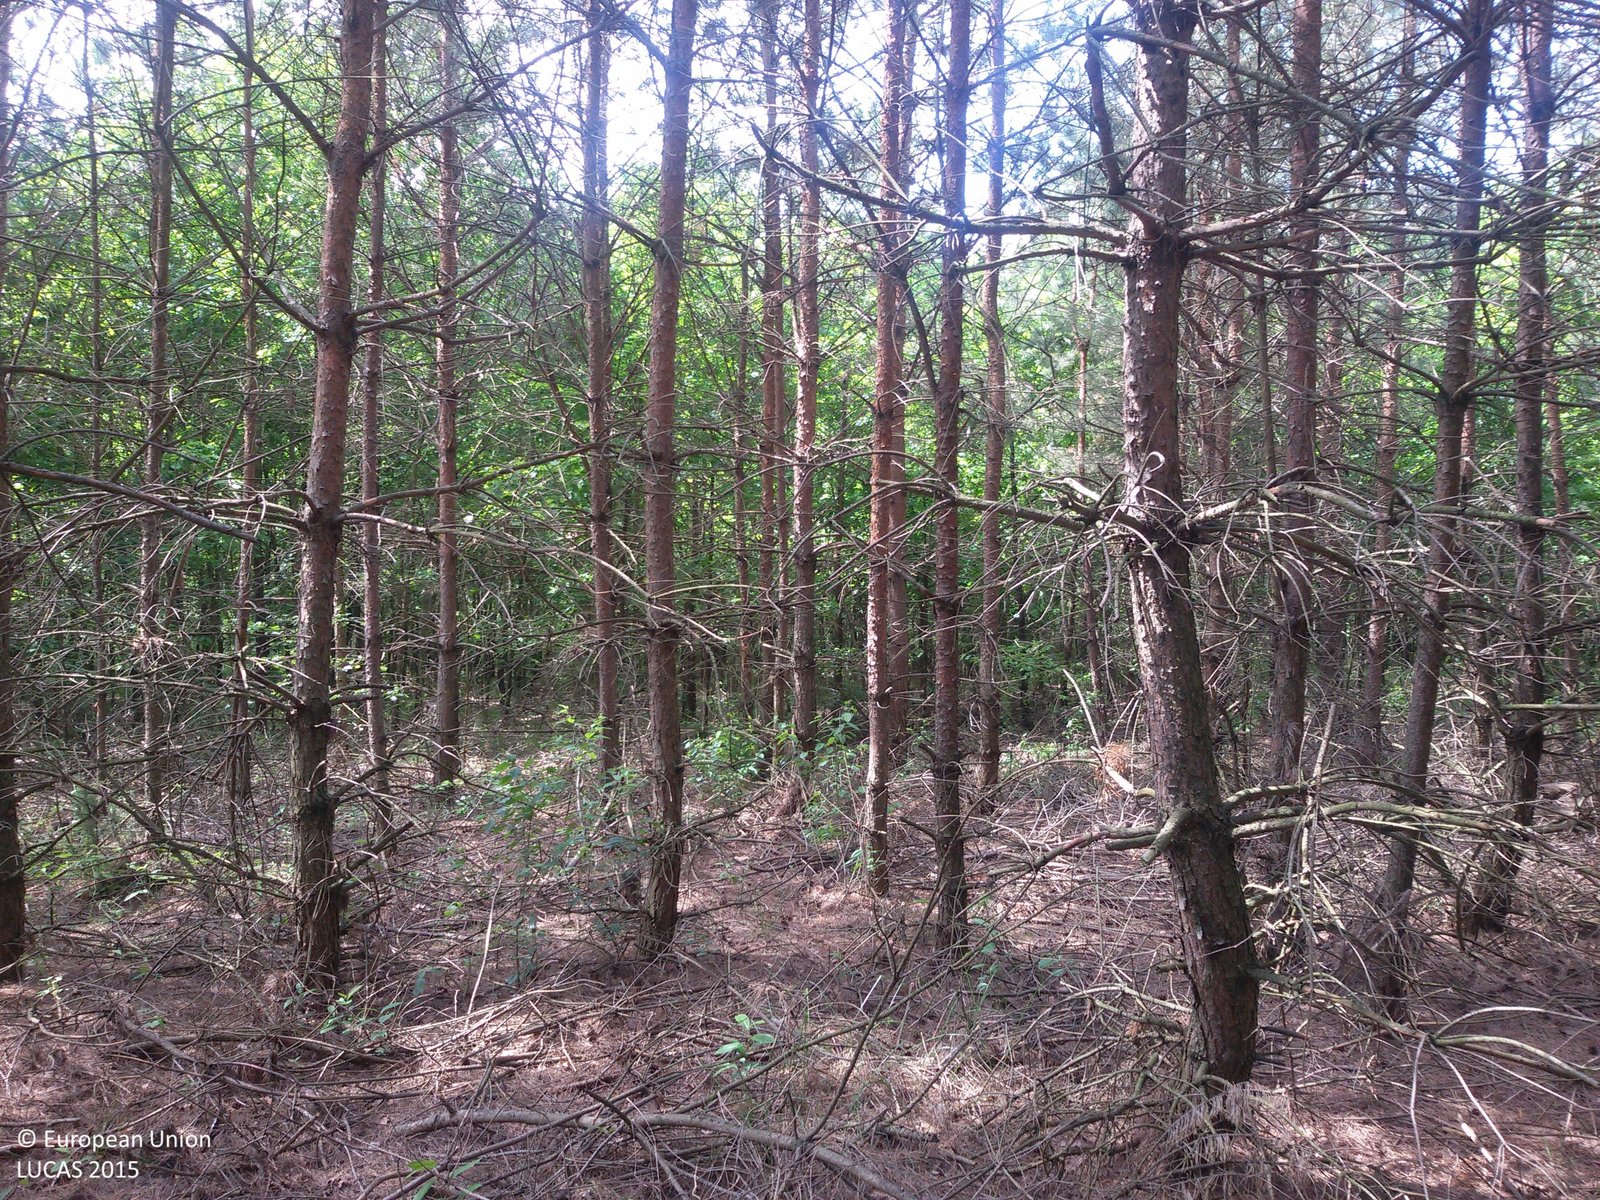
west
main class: Woodland
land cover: Pine dominated coniferous woodland
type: hemiboreal forest and nemoral coniferous forest and mixed broadleaved-coniferous forest
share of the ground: > 75 %
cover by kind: coniferous forest trees 90 %, broadleaved forest trees 5 %, shrubs 5 %
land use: Forestry
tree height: > 5 m
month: June
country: PL
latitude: 51.5174
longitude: 22.7964
